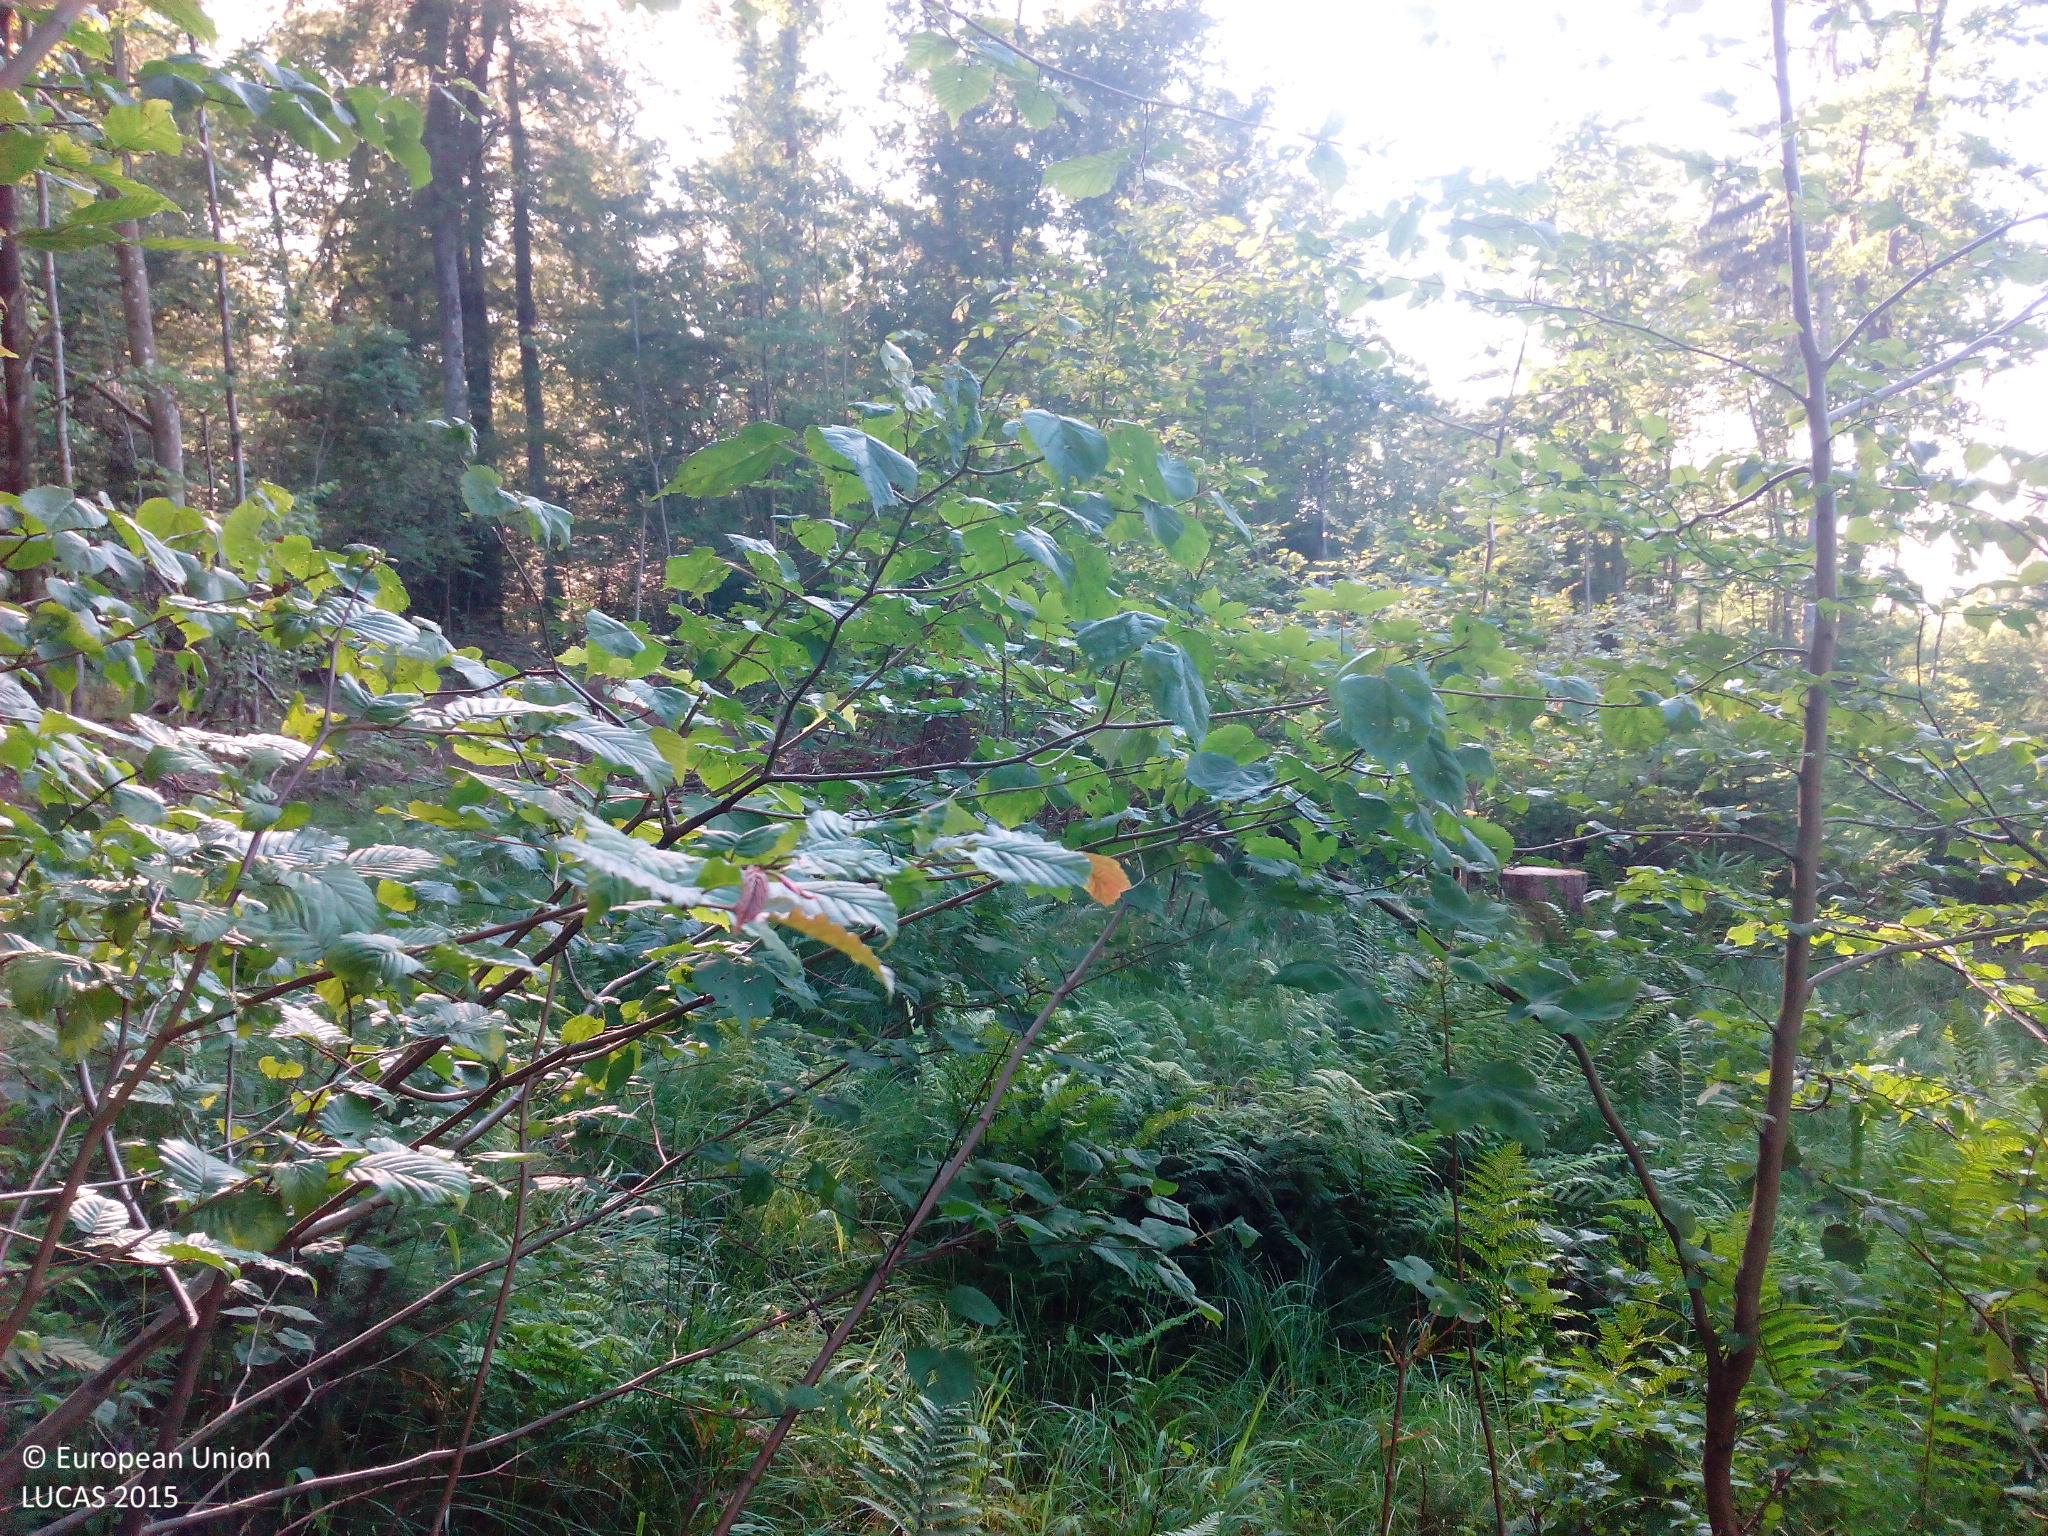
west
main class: Woodland
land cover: Spruce dominated mixed woodland
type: hemiboreal forest and nemoral coniferous forest and mixed broadleaved-coniferous forest
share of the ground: 50 - 75 %
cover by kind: coniferous forest trees 25 %, broadleaved forest trees 25 %, shrubs 25 %, herbaceous plants 25 %
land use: Forestry
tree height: > 5 m
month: June
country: DE
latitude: 48.5997
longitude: 9.3901
